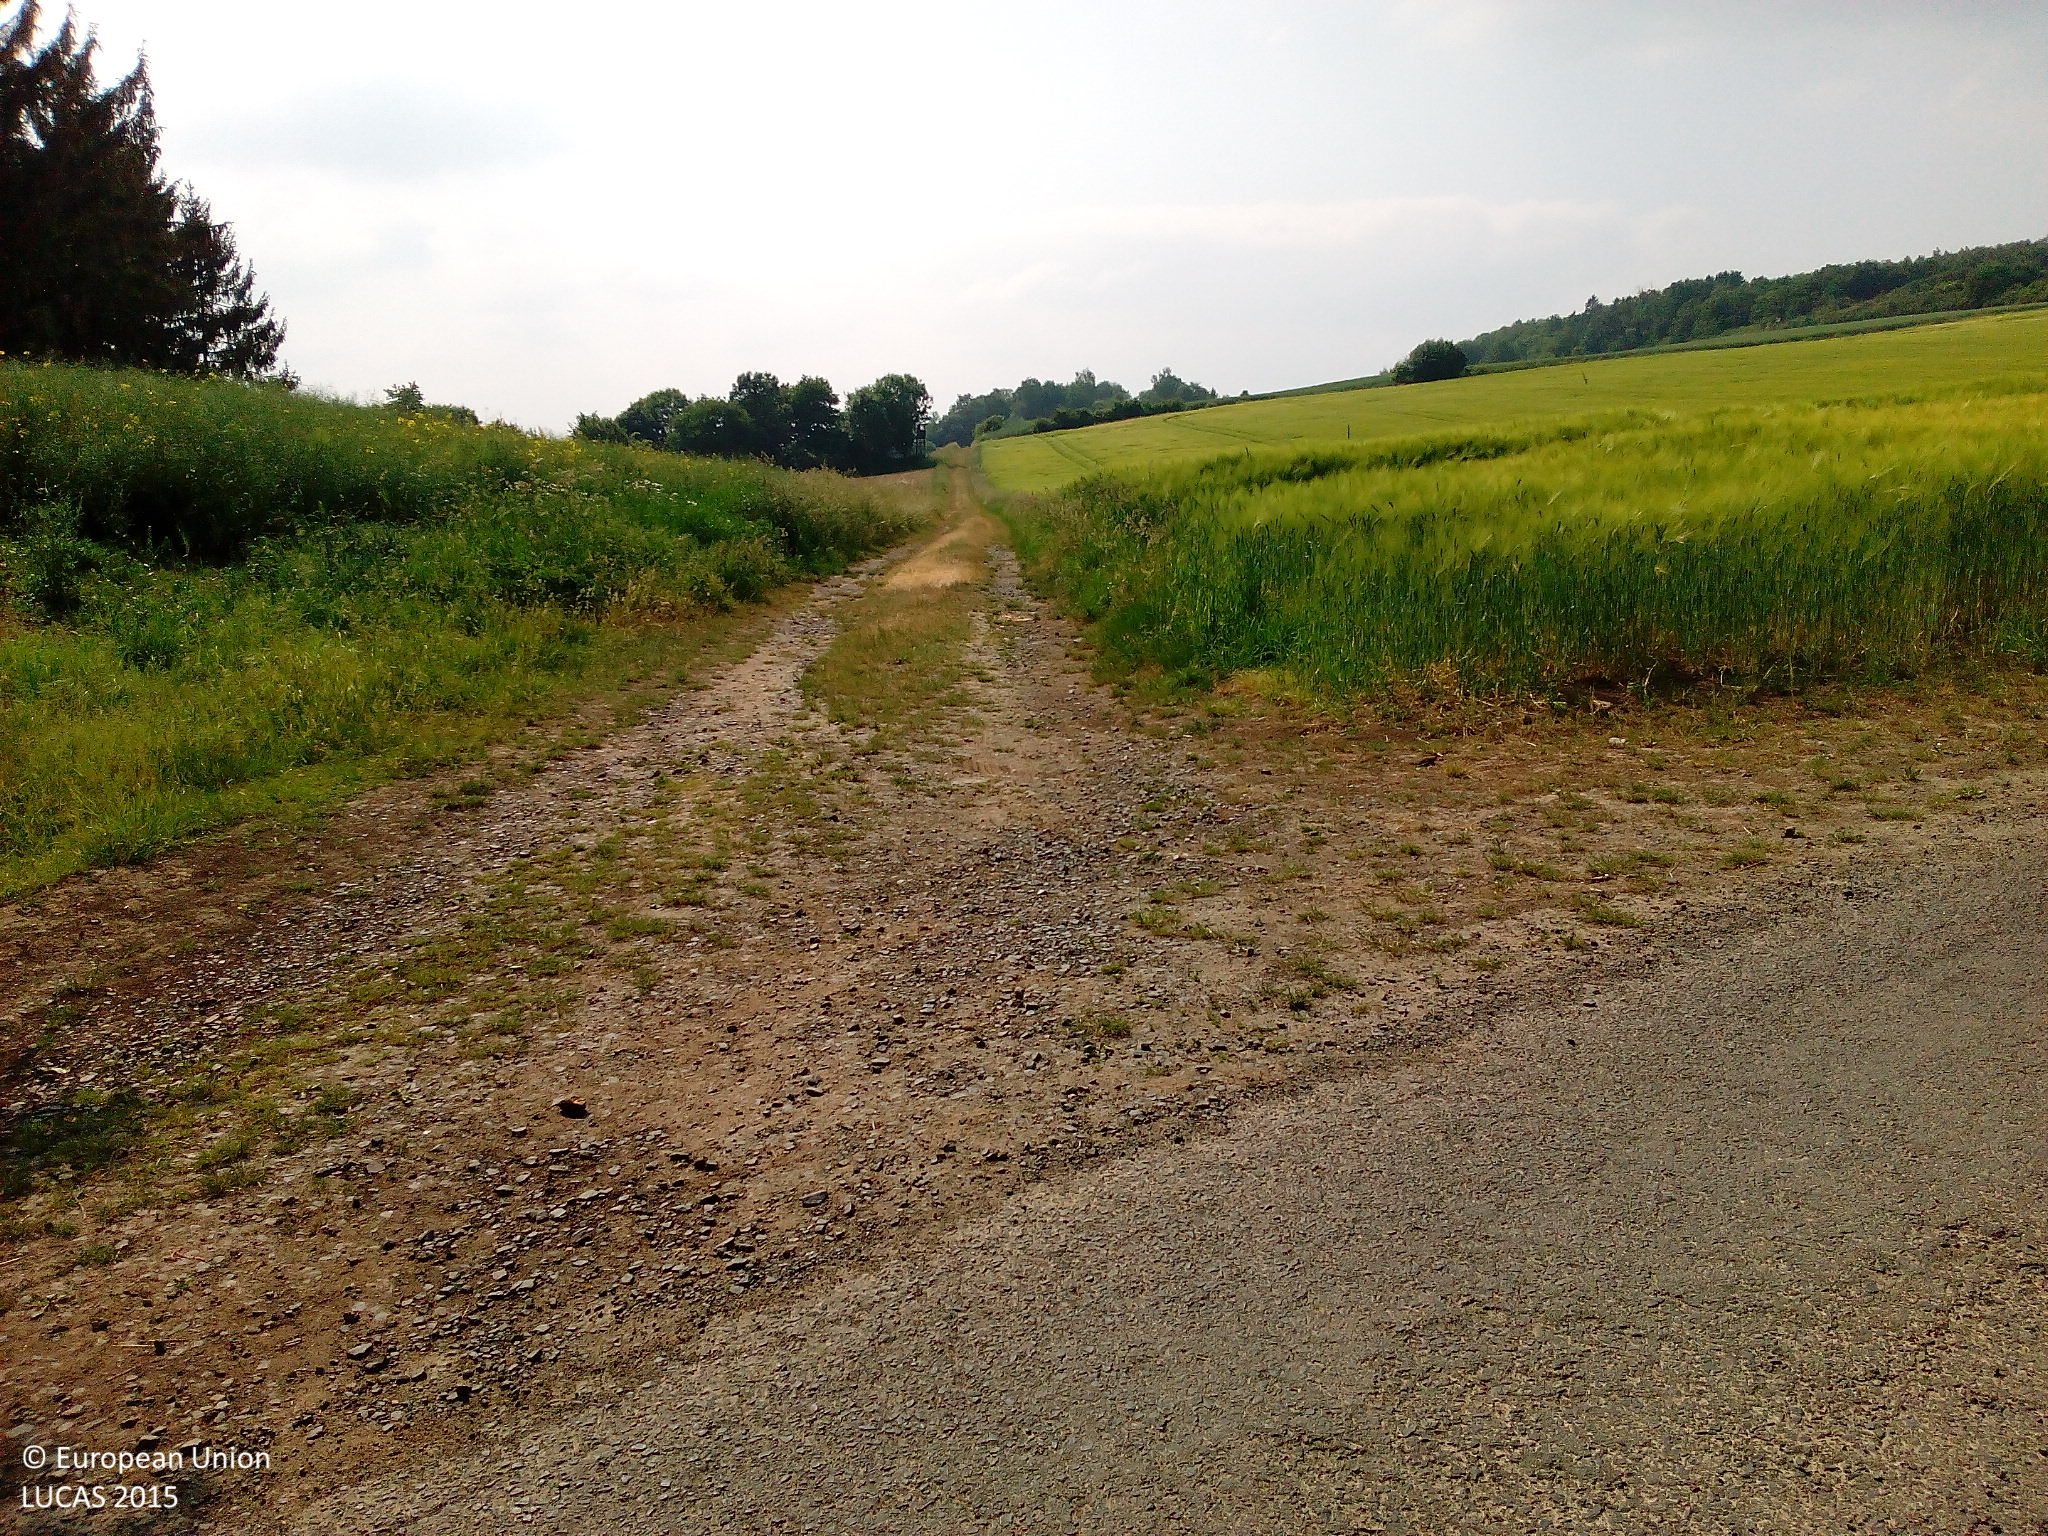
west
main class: Woodland
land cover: Broadleaved woodland
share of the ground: > 75 %
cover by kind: broadleaved forest trees 100 %
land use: Forestry
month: June
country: DE
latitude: 51.1893
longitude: 9.3563
